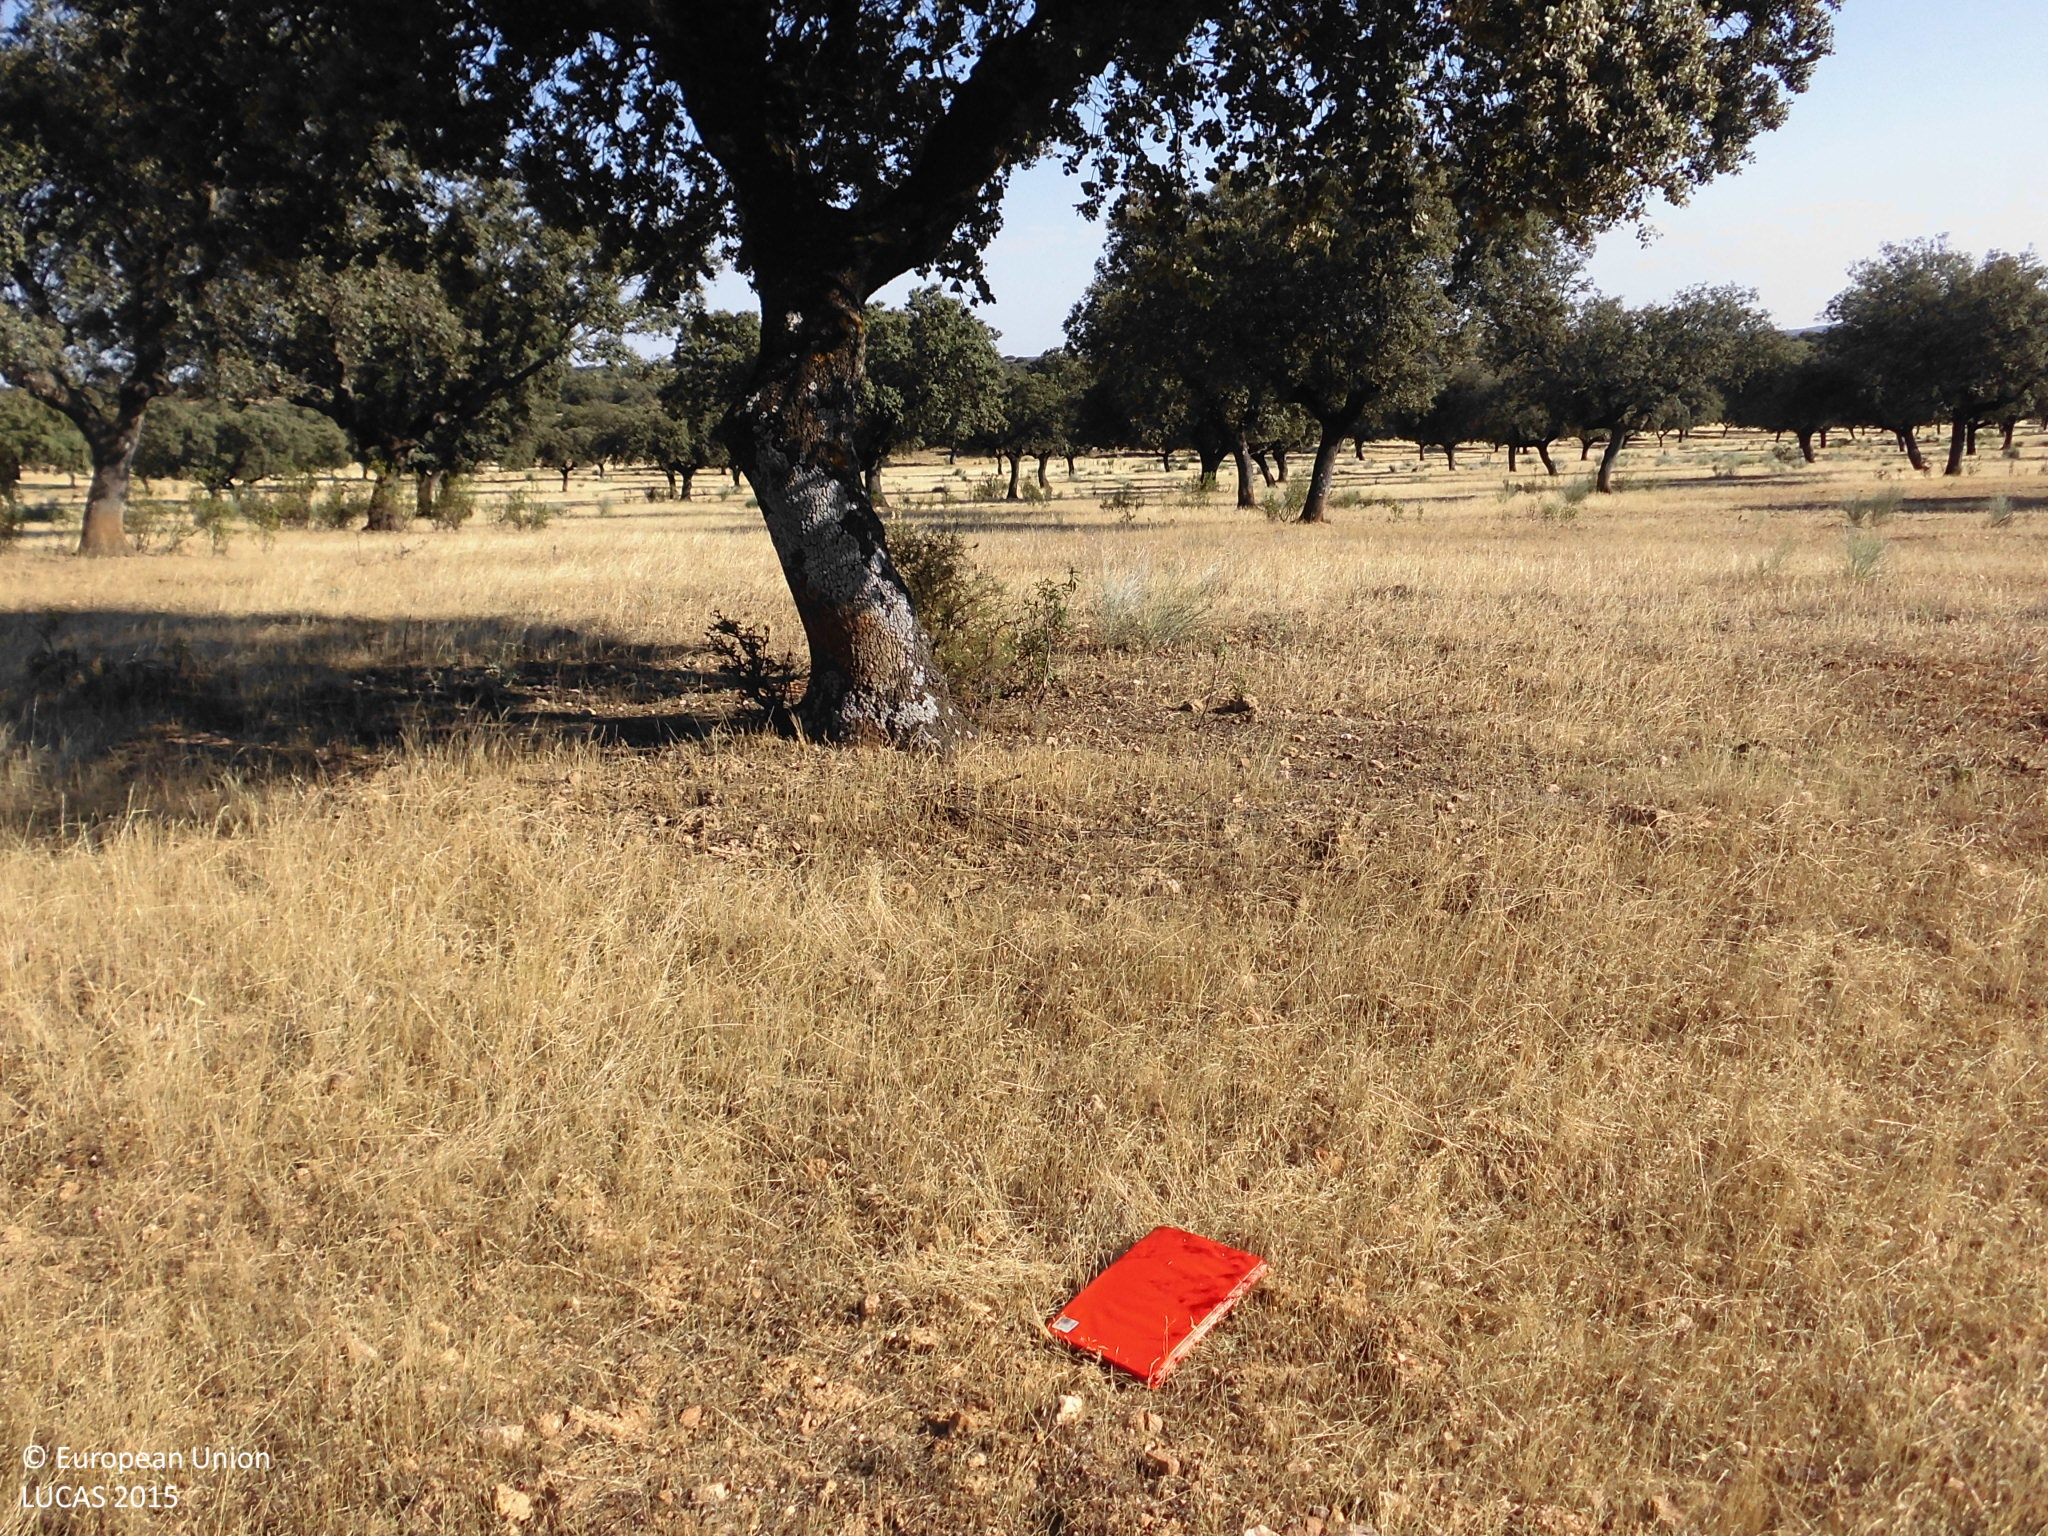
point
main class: Woodland
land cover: Broadleaved woodland
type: broadleaved evergreen forest
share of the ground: 10 - 25 %
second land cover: Grassland without tree/shrub cover
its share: > 75 %
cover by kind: herbaceous plants 75 %, broadleaved forest trees 25 %
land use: Forestry
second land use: Agriculture (excluding fallow land and kitchen gardens)
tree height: > 5 m
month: June
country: ES
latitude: 39.7977
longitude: -5.9602
